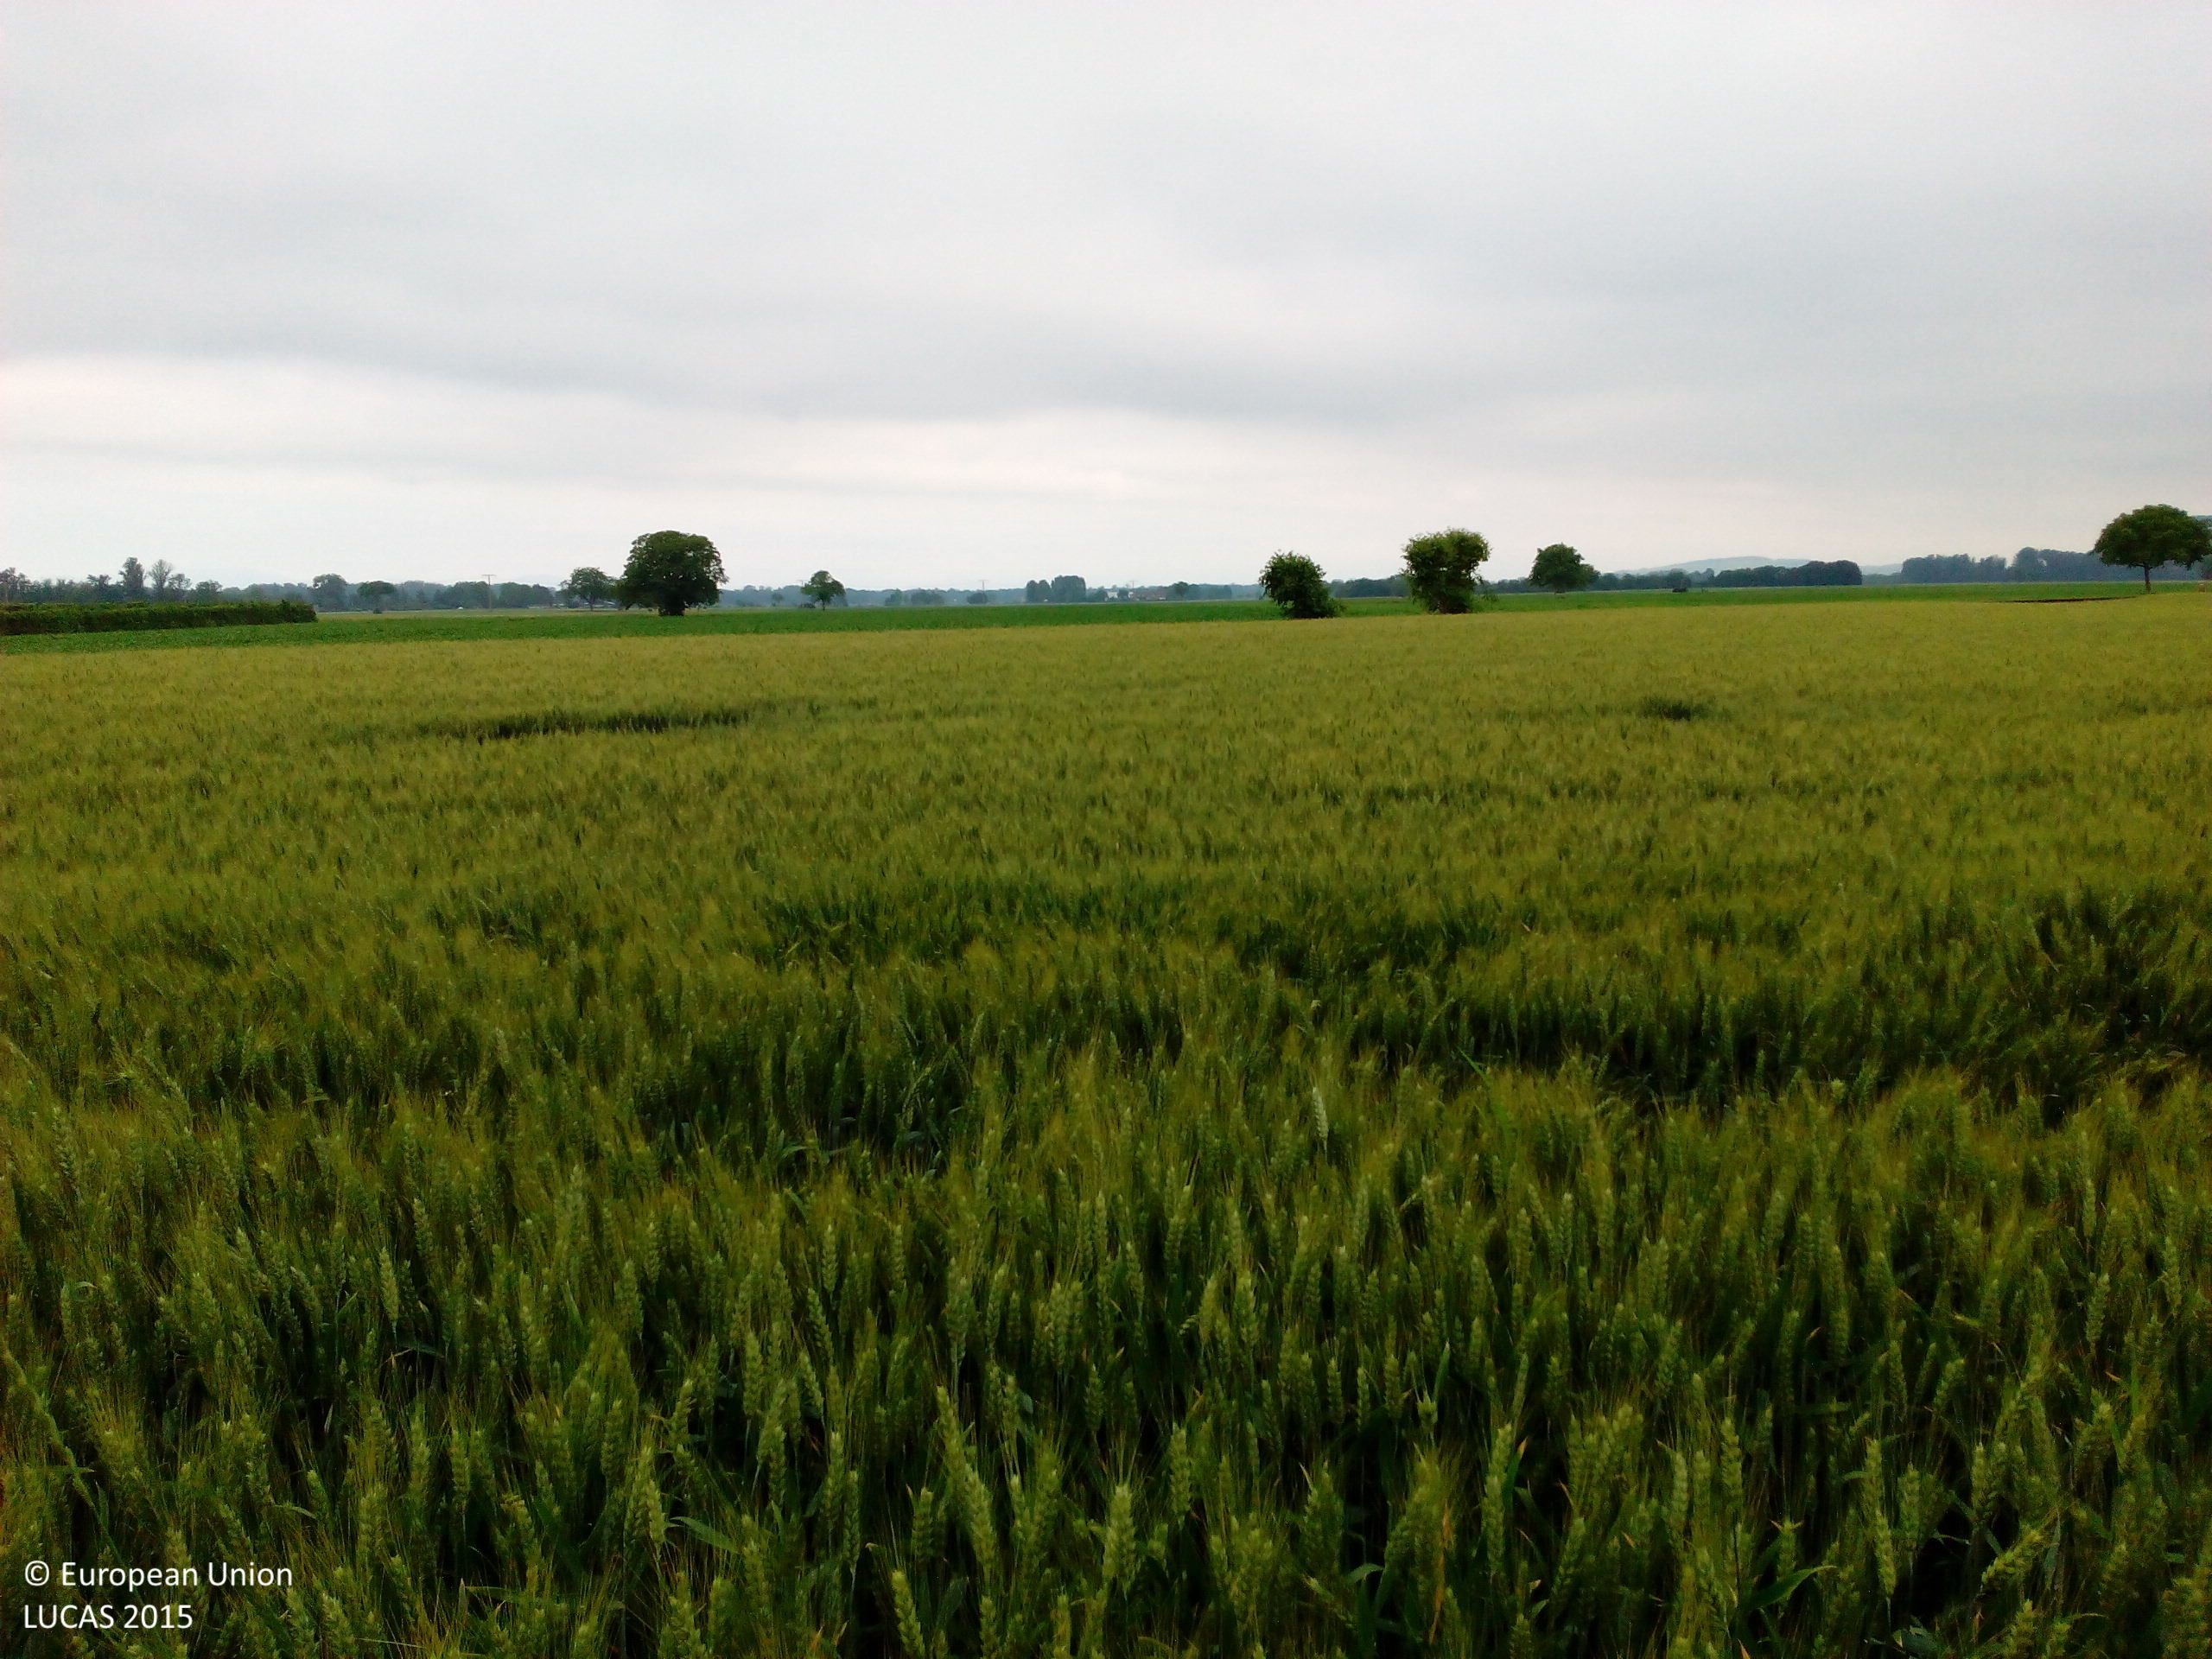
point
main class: Cropland
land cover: Durum wheat
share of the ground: > 75 %
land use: Agriculture (excluding fallow land and kitchen gardens)
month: June
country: DE
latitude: 48.0354
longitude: 7.6005
